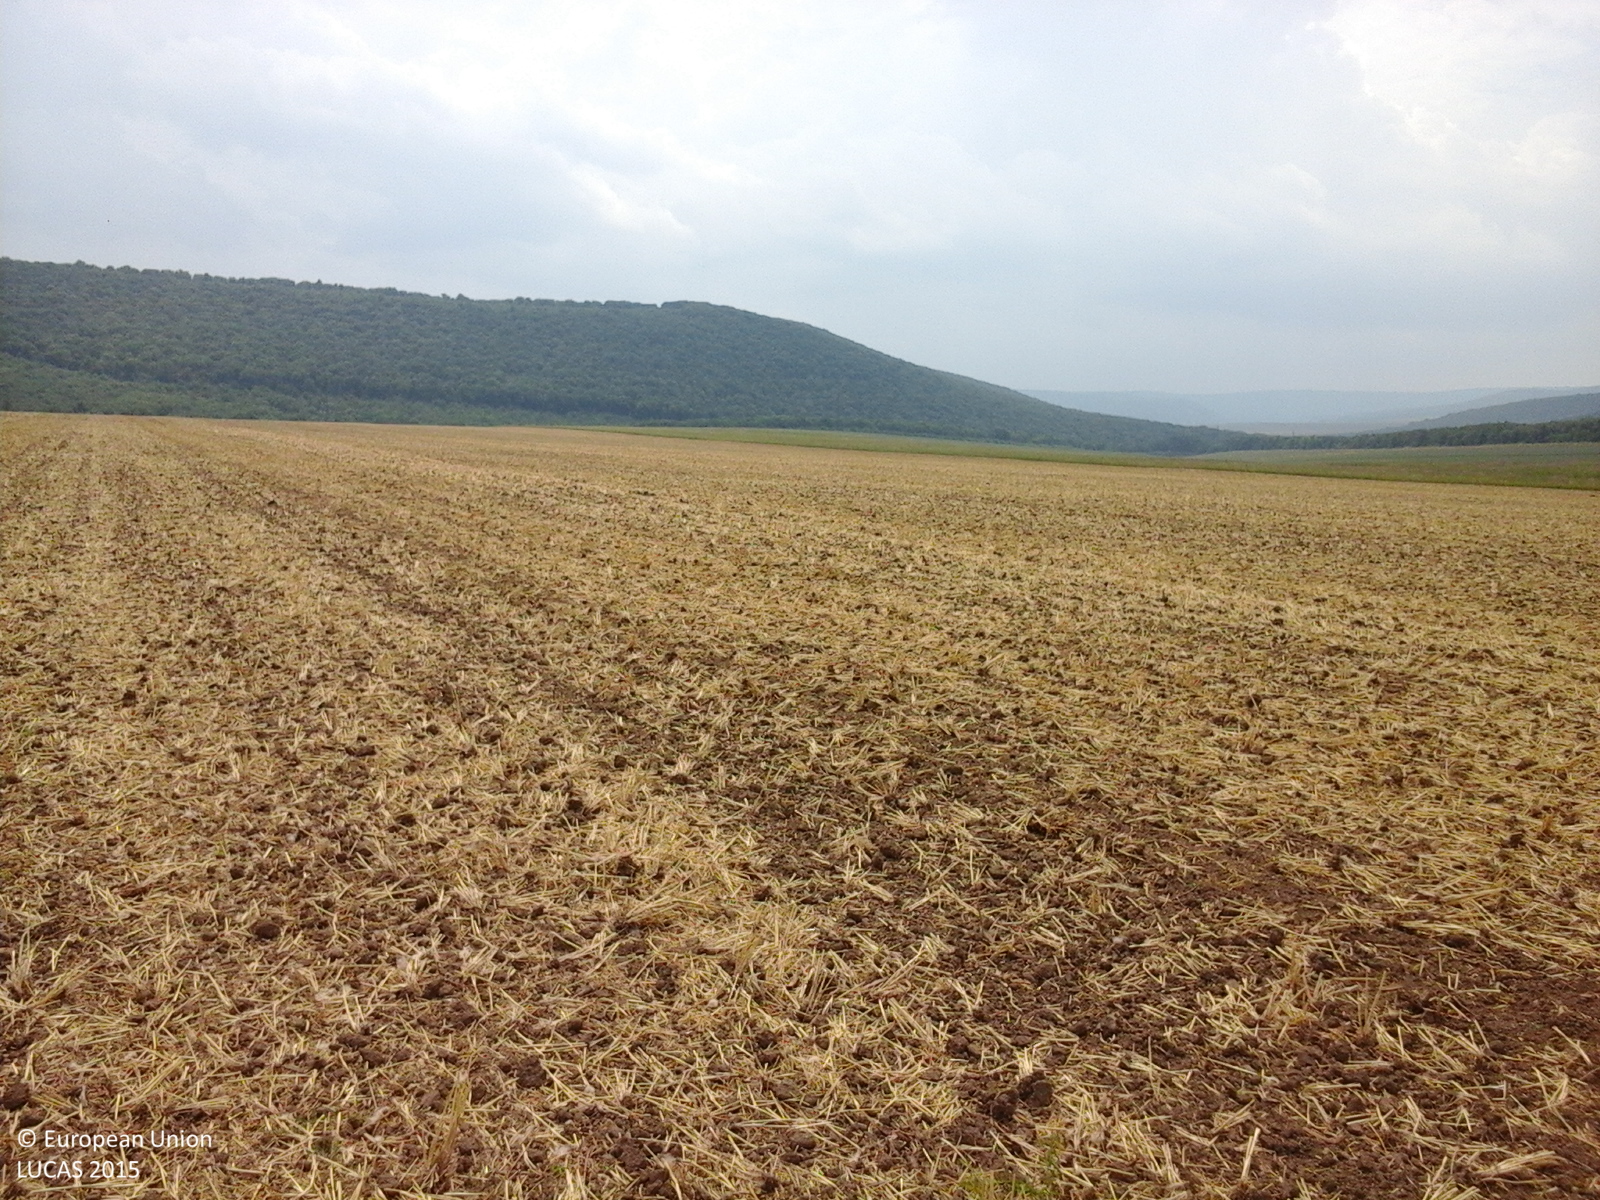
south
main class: Cropland
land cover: Durum wheat
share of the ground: < 10 %
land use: Agriculture (excluding fallow land and kitchen gardens)
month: July
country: RO
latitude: 44.9024
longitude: 28.6088
